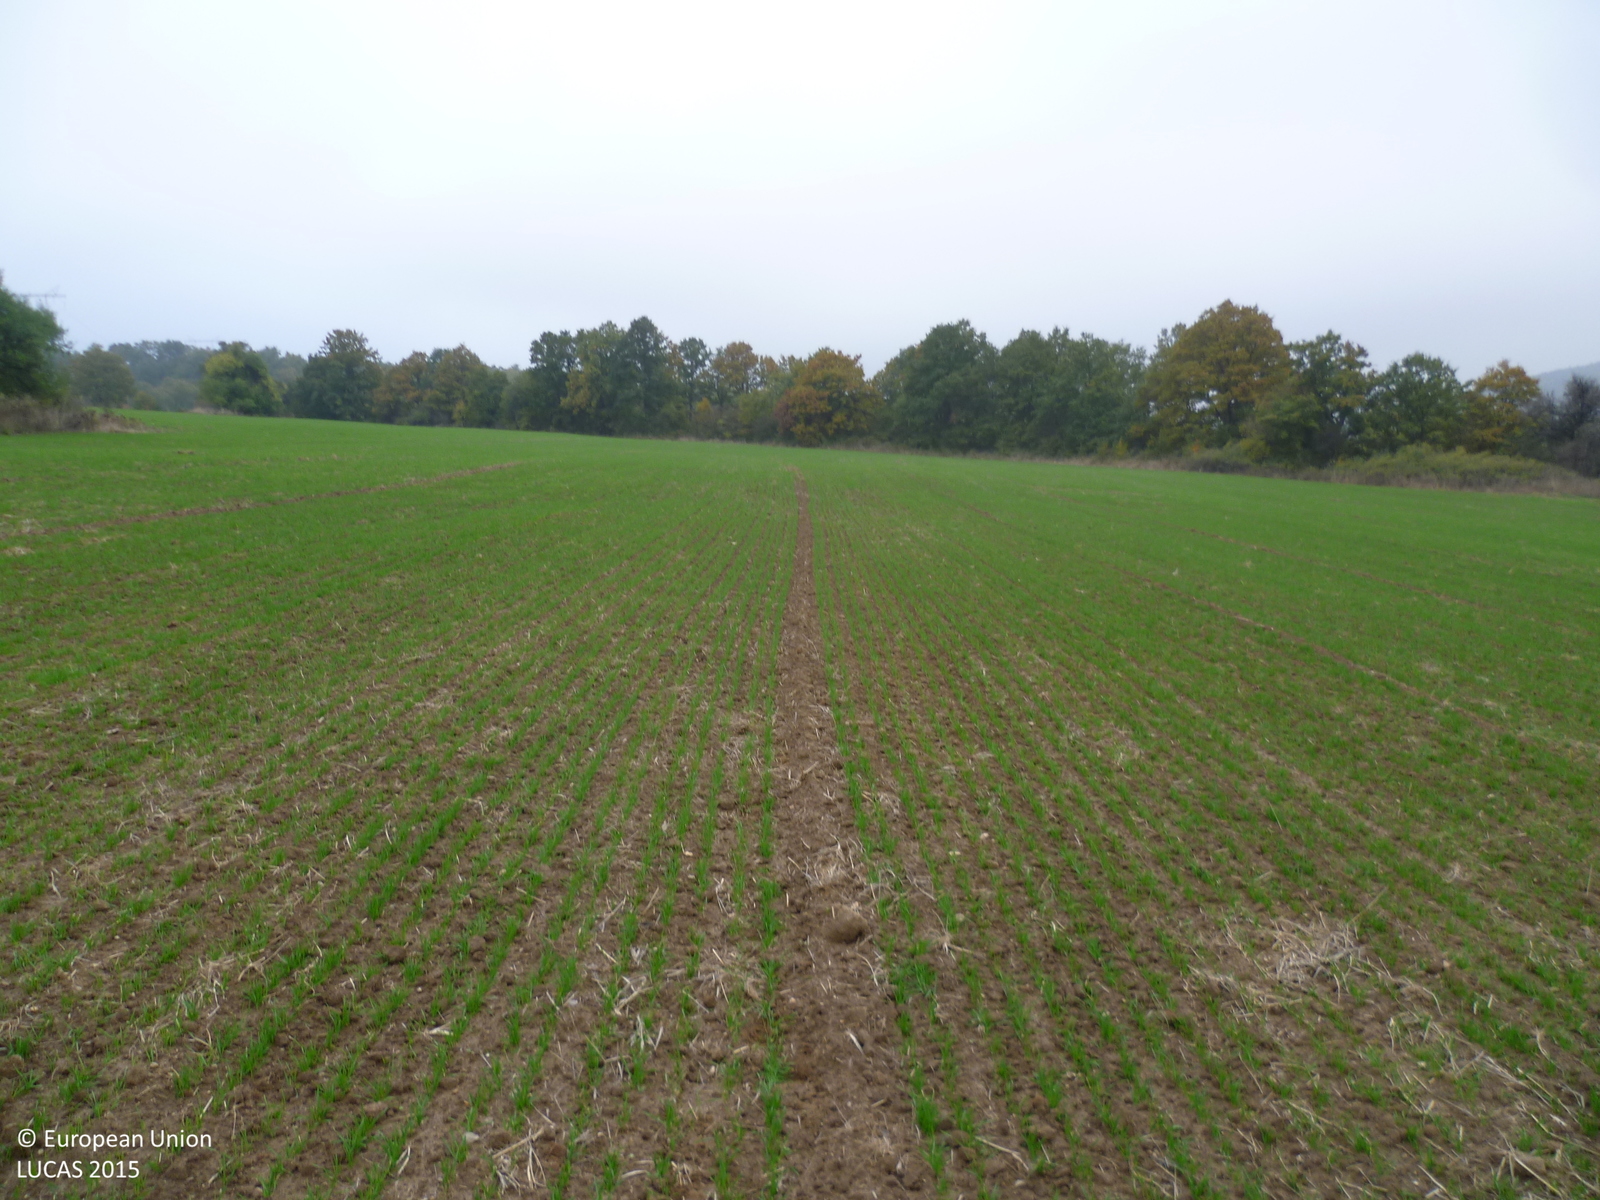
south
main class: Cropland
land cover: Durum wheat
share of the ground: 25 - 50 %
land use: Agriculture (excluding fallow land and kitchen gardens)
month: October
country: BG
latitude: 42.3891
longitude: 23.8750
